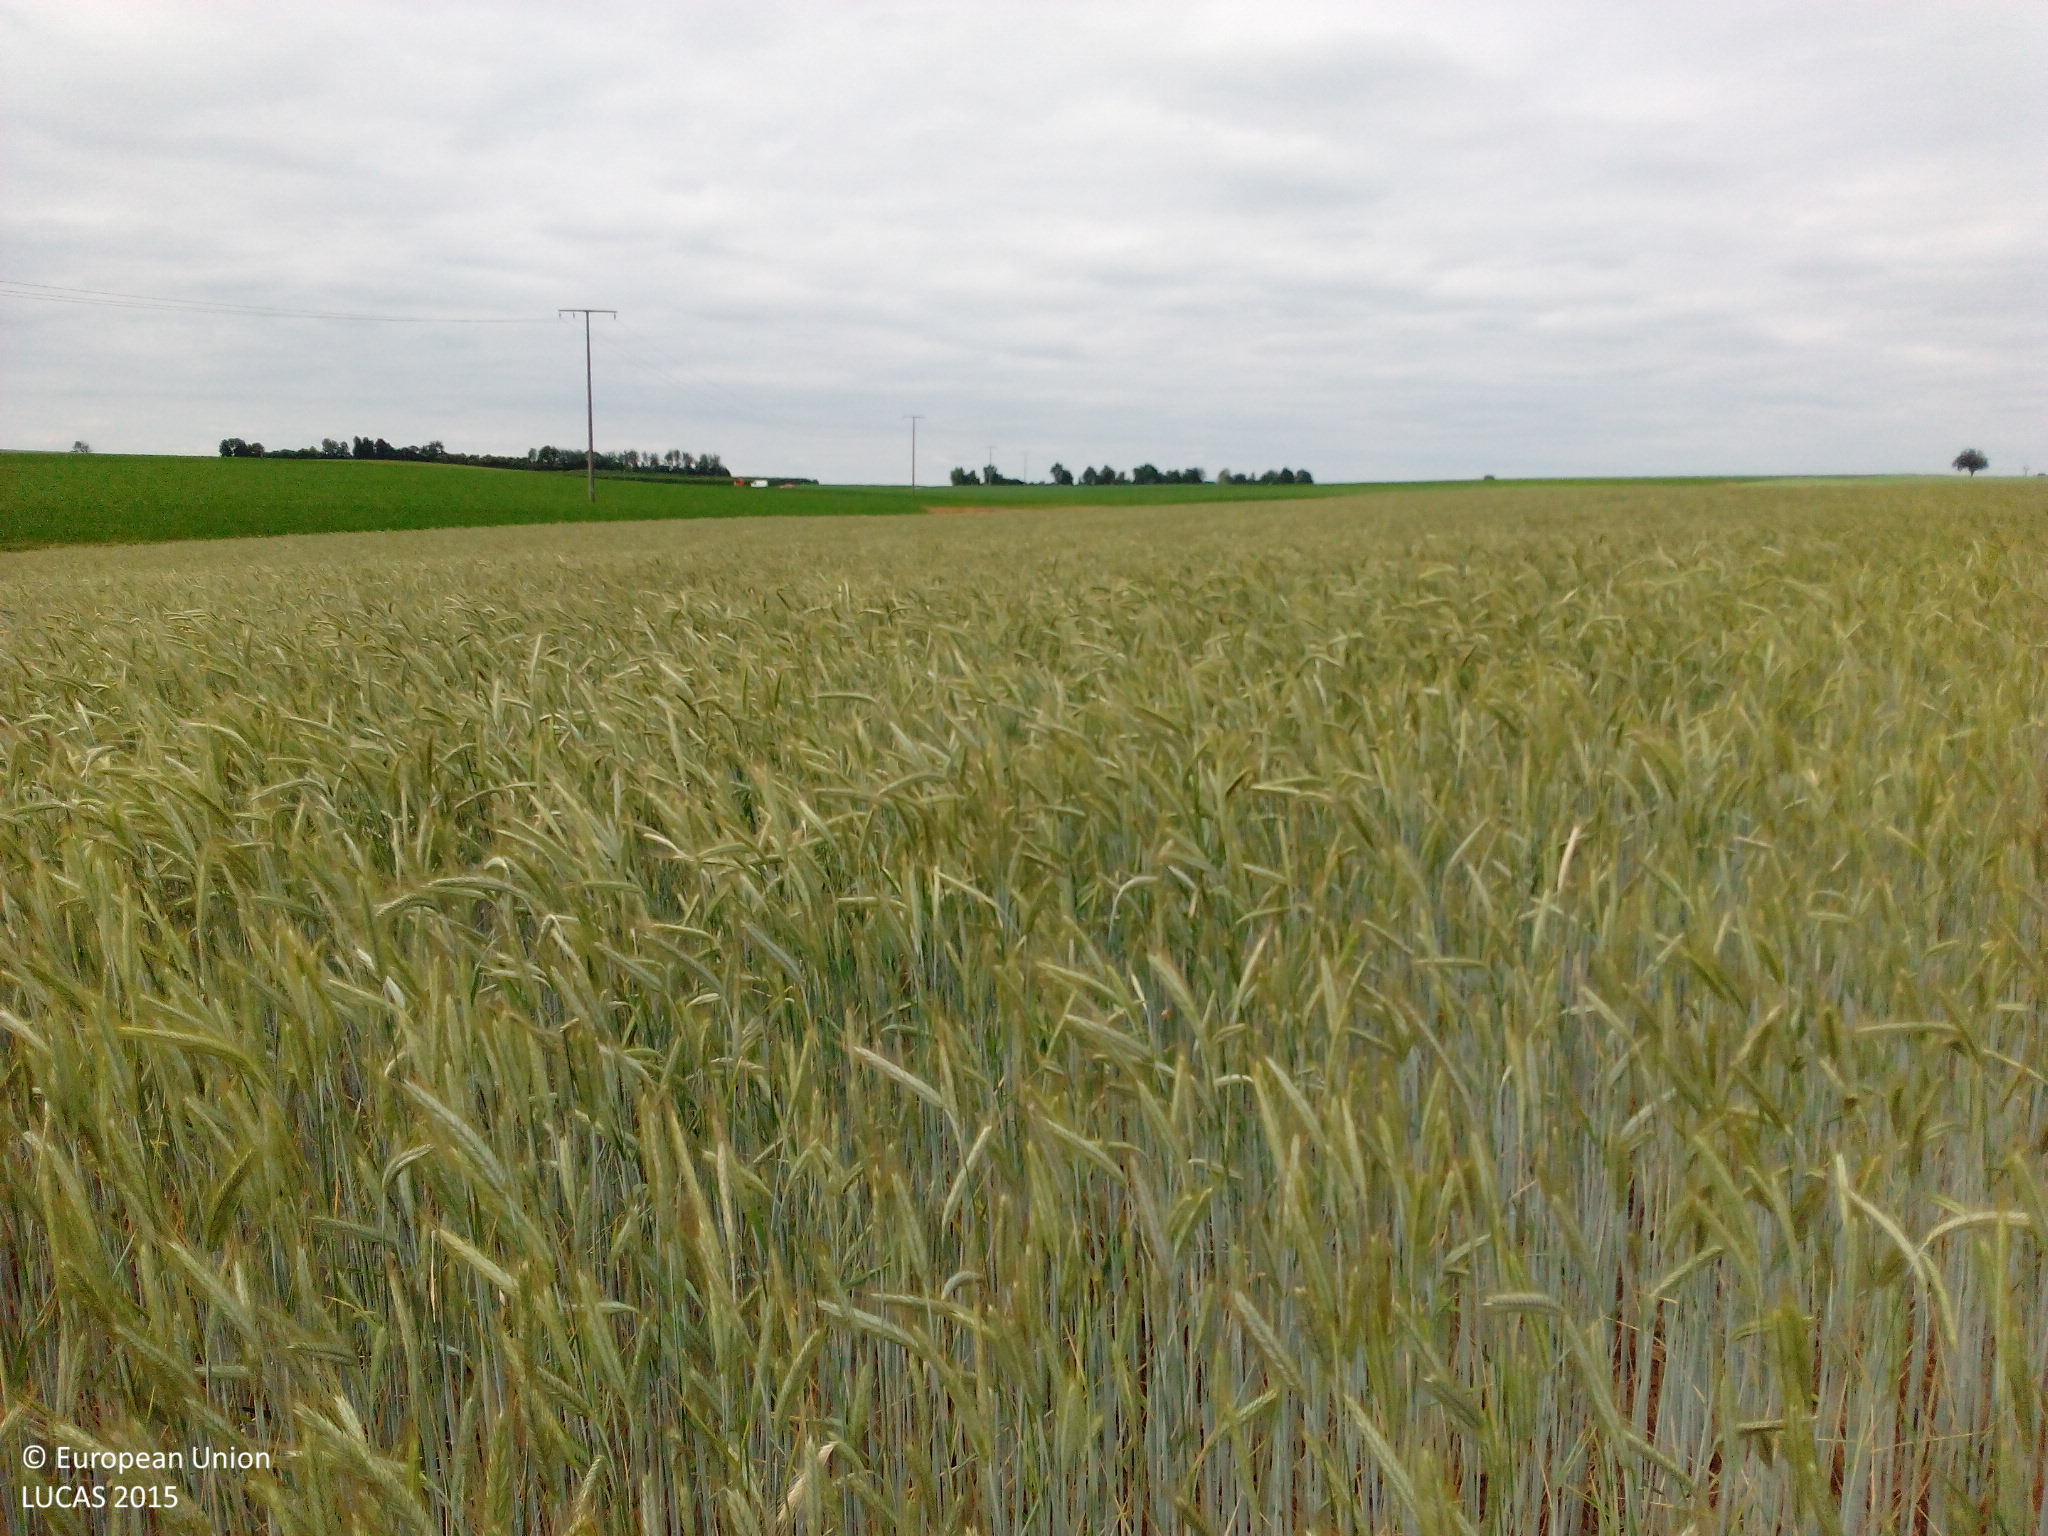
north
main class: Cropland
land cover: Barley
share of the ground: > 75 %
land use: Agriculture (excluding fallow land and kitchen gardens)
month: June
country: DE
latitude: 49.2647
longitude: 9.2720
